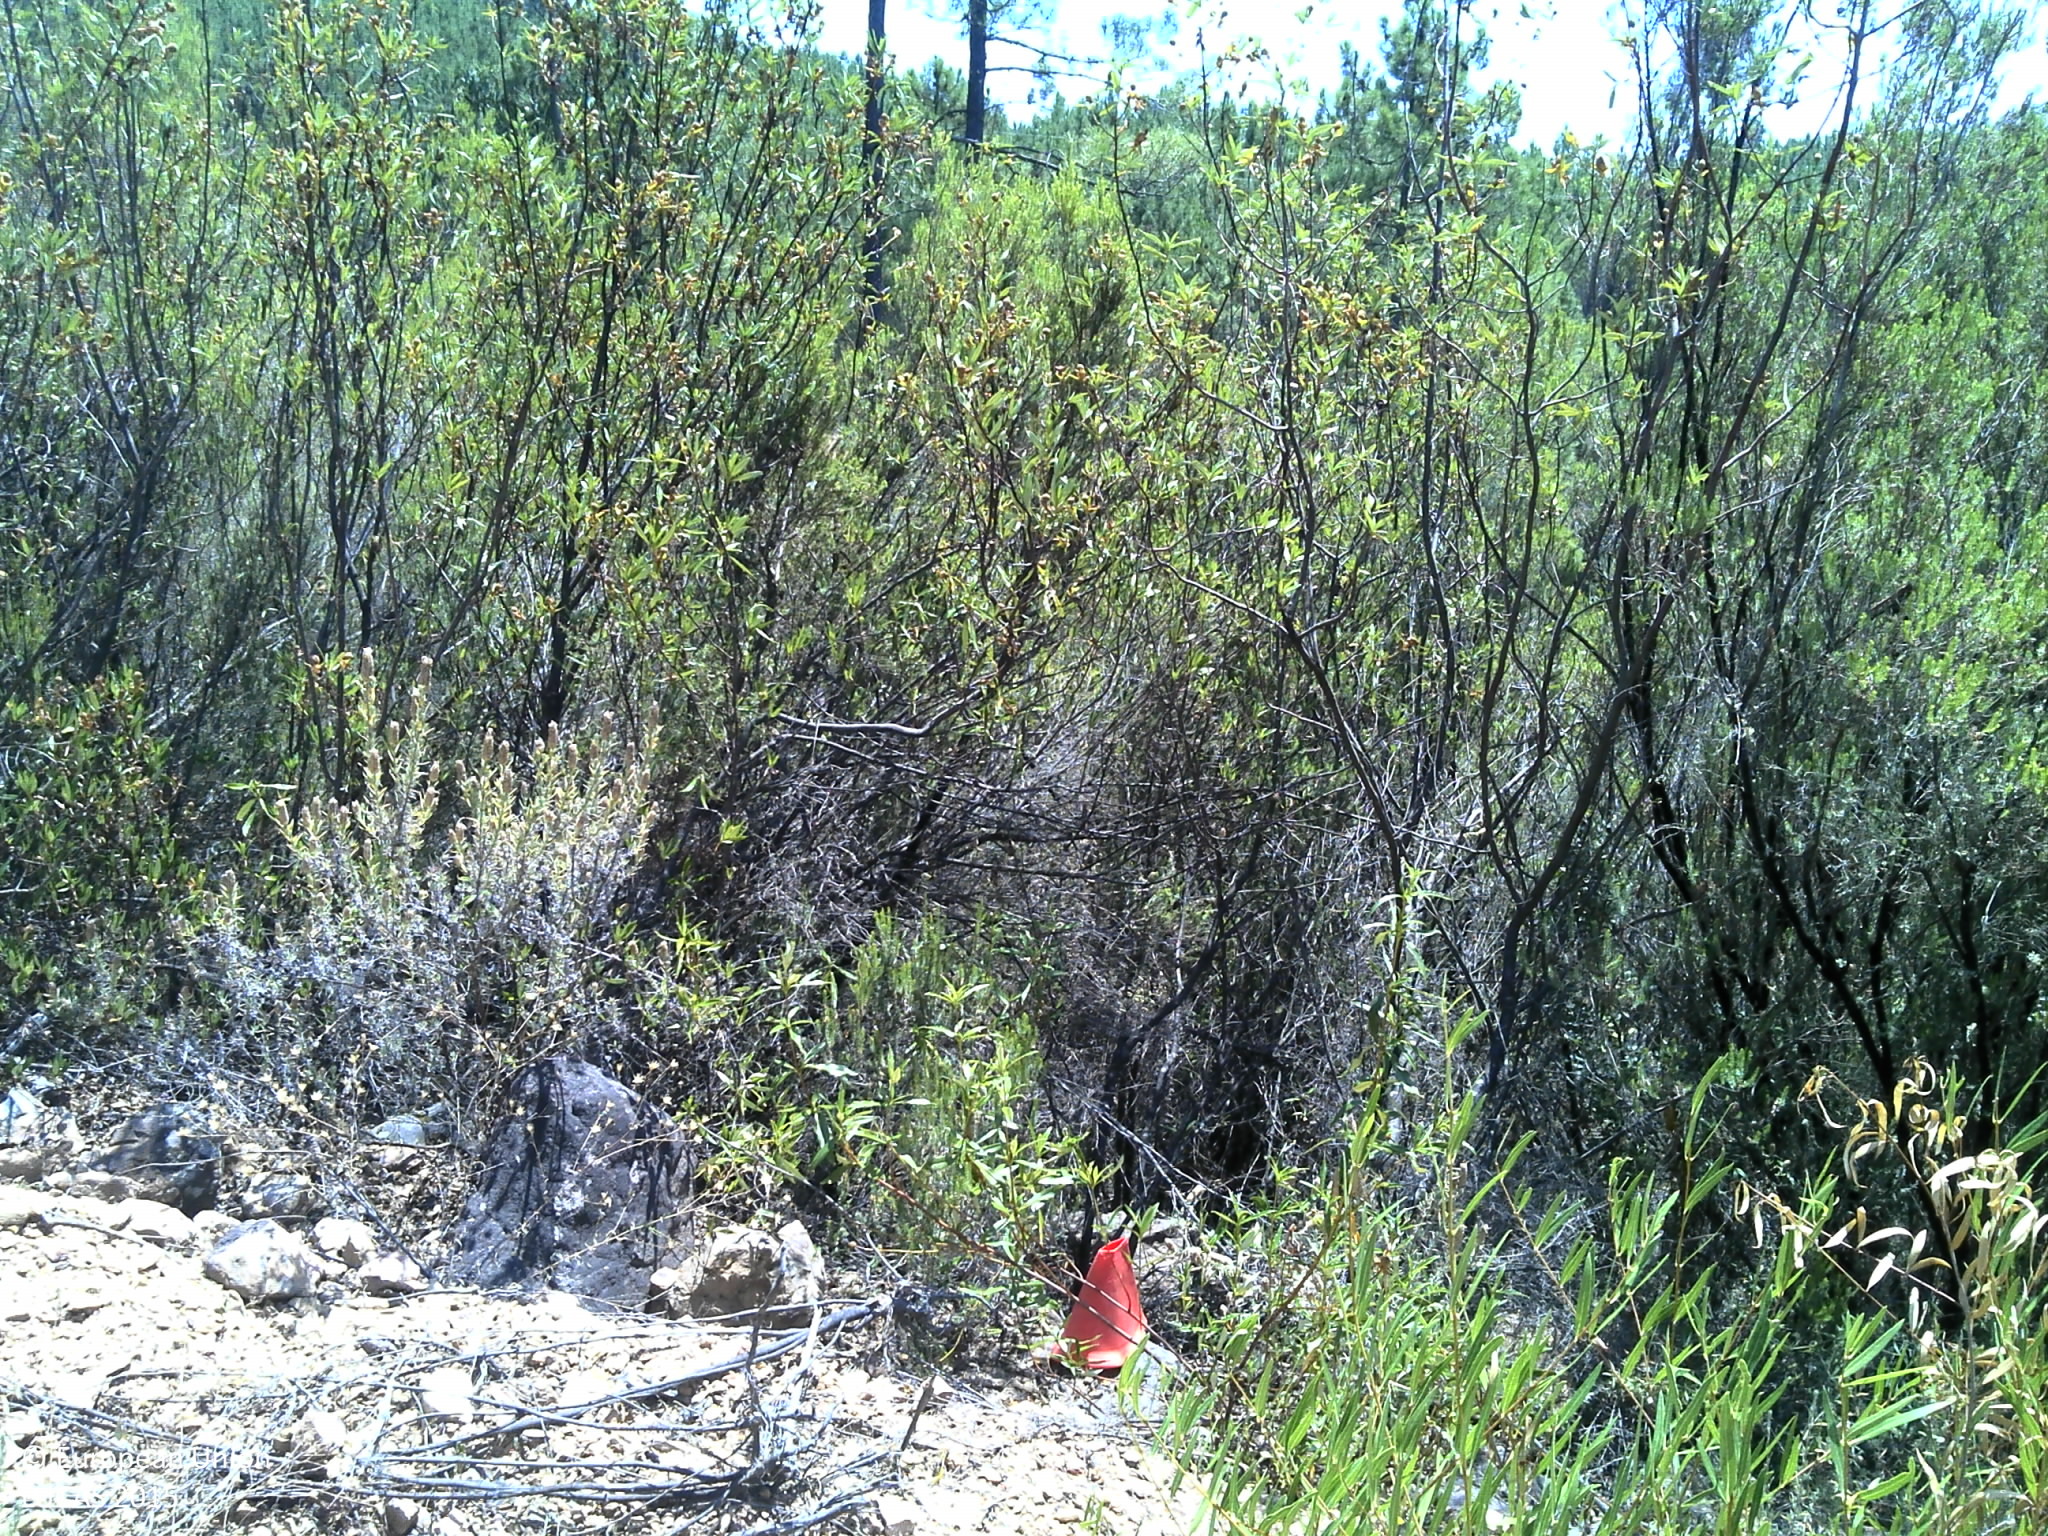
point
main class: Shrubland
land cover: Shrubland with sparse tree cover
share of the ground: > 75 %
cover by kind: shrubs 80 %, unconsolidated bare surface 15 %, coniferous forest trees 5 %
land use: Semi-natural and natural areas not in use
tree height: > 5 m
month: July
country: PT
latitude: 39.5972
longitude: -7.9347
